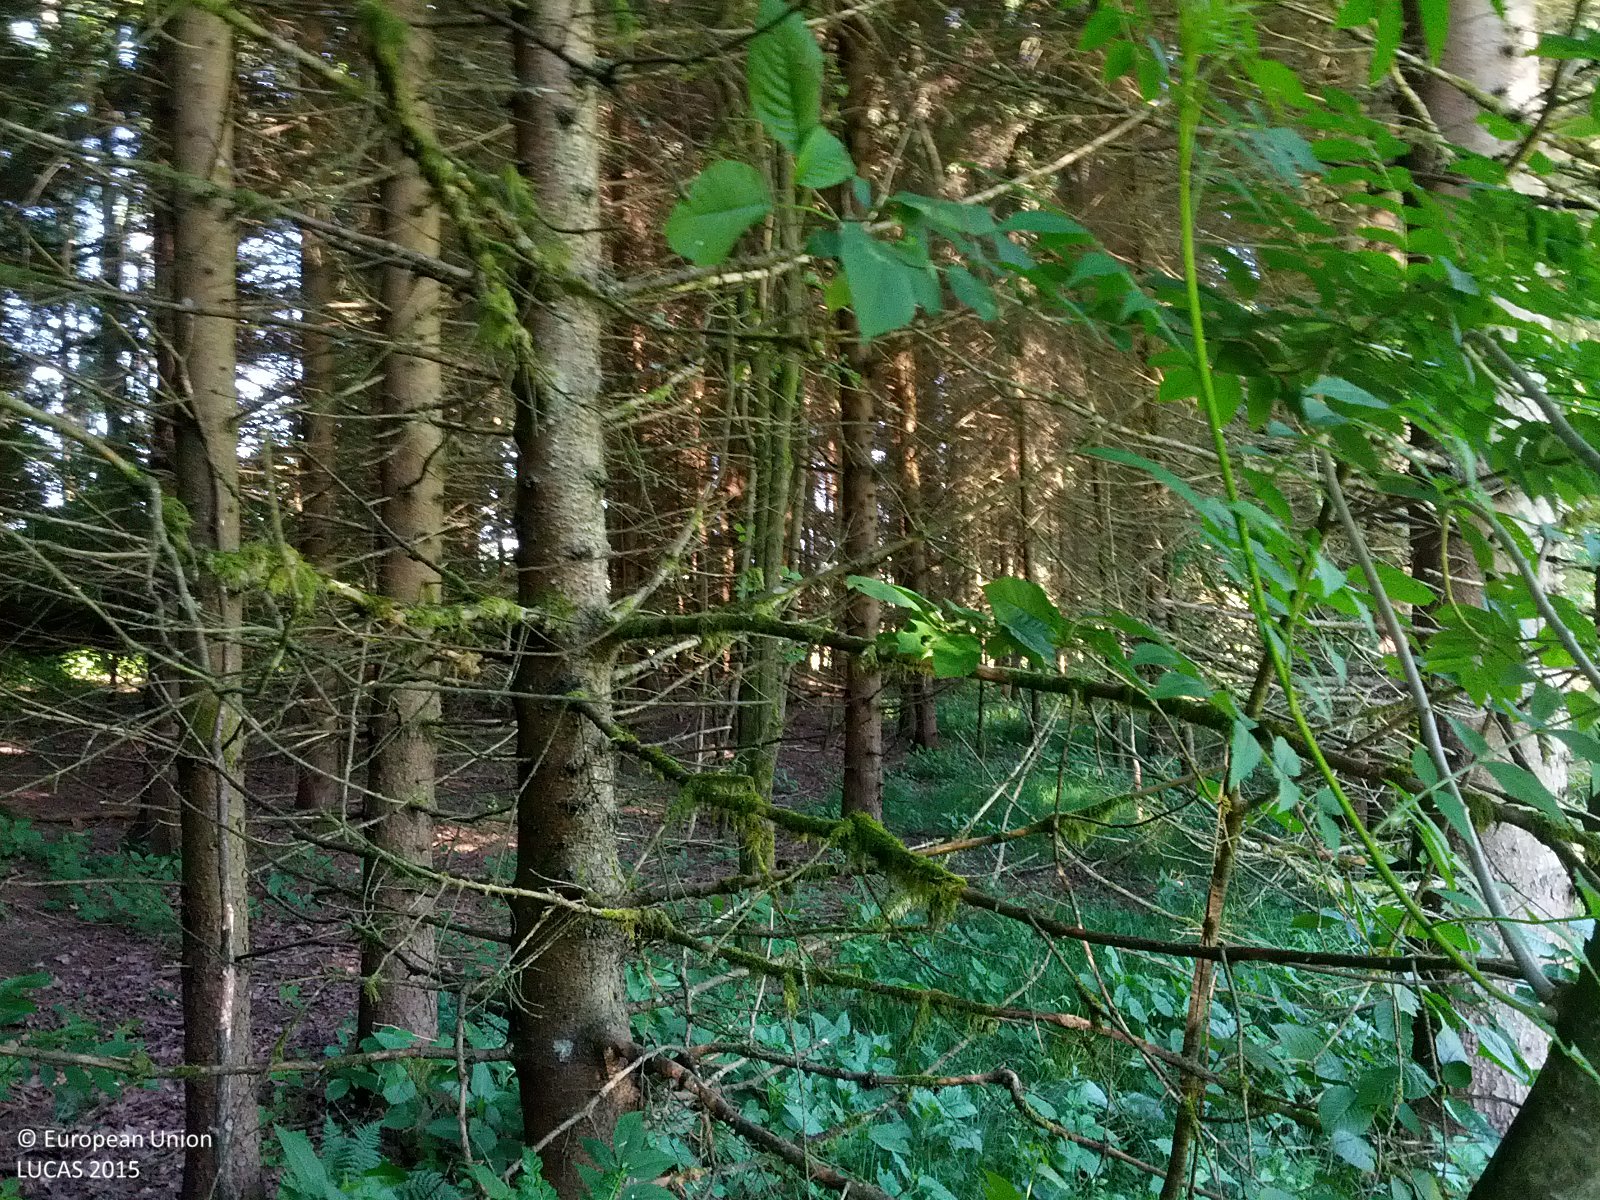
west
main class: Woodland
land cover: Spruce dominated coniferous woodland
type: hemiboreal forest and nemoral coniferous forest and mixed broadleaved-coniferous forest
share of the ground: > 75 %
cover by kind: coniferous forest trees 85 %, herbaceous plants 10 %, broadleaved forest trees 5 %
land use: Forestry
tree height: > 5 m
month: June
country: AT
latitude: 47.2025
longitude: 16.1669
